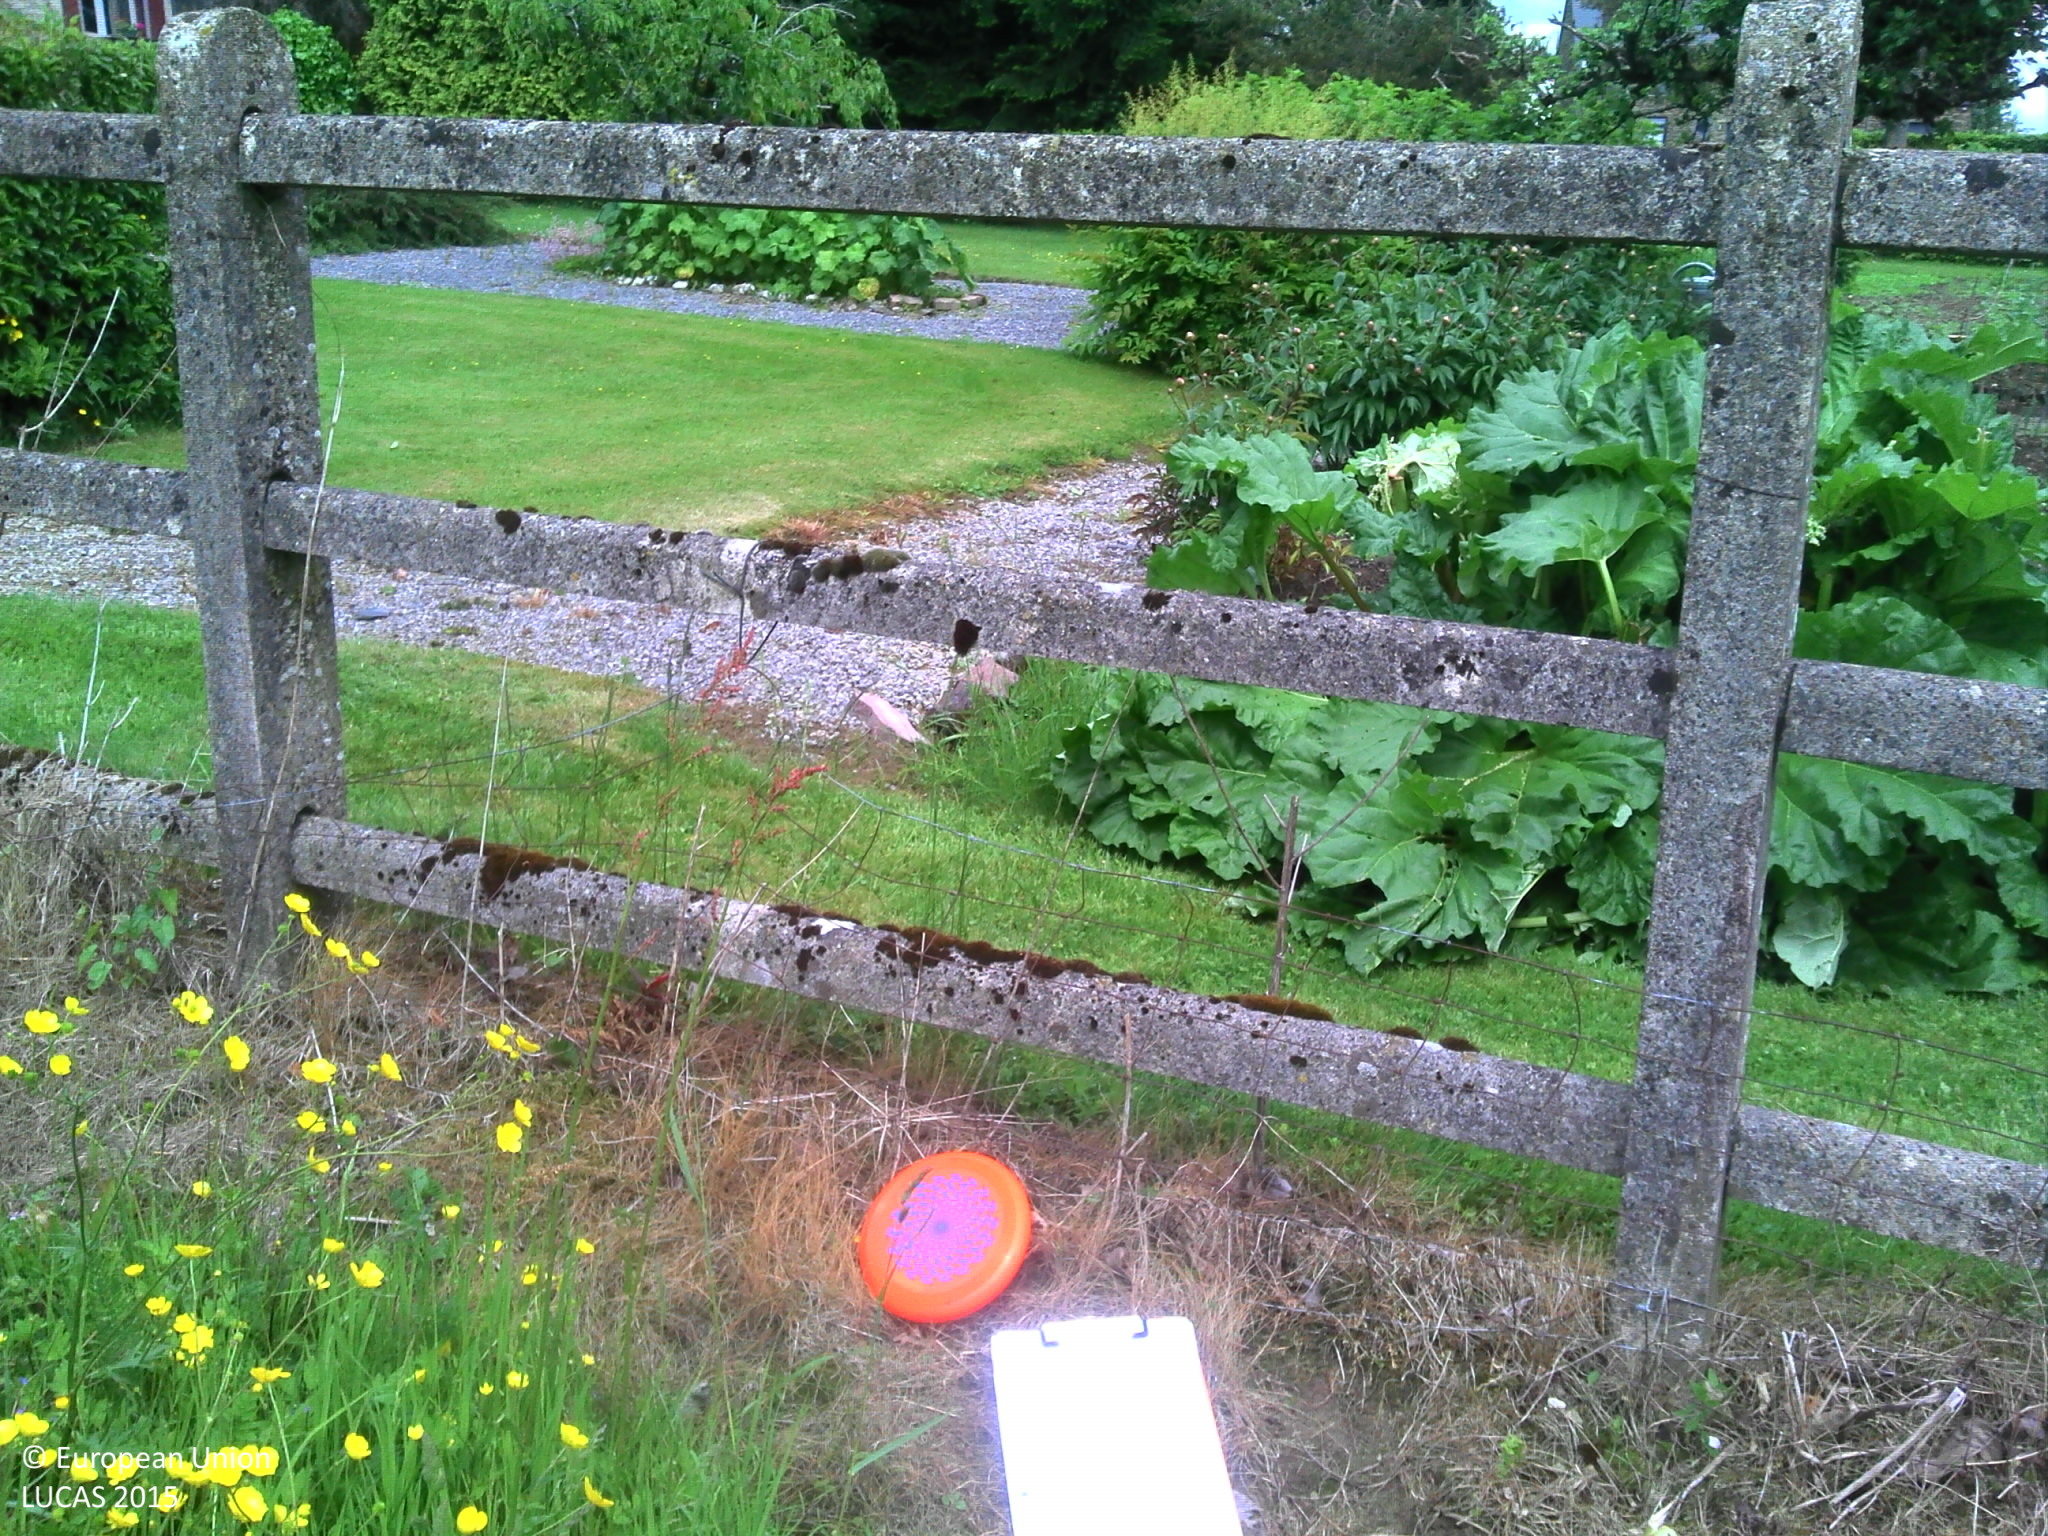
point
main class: Grassland
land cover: Grassland with sparse tree/shrub cover
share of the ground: > 75 %
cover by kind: herbaceous plants 90 %, broadleaved forest trees 5 %, unconsolidated bare surface 5 %
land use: Residential
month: June
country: BE
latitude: 49.8177
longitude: 4.8964
